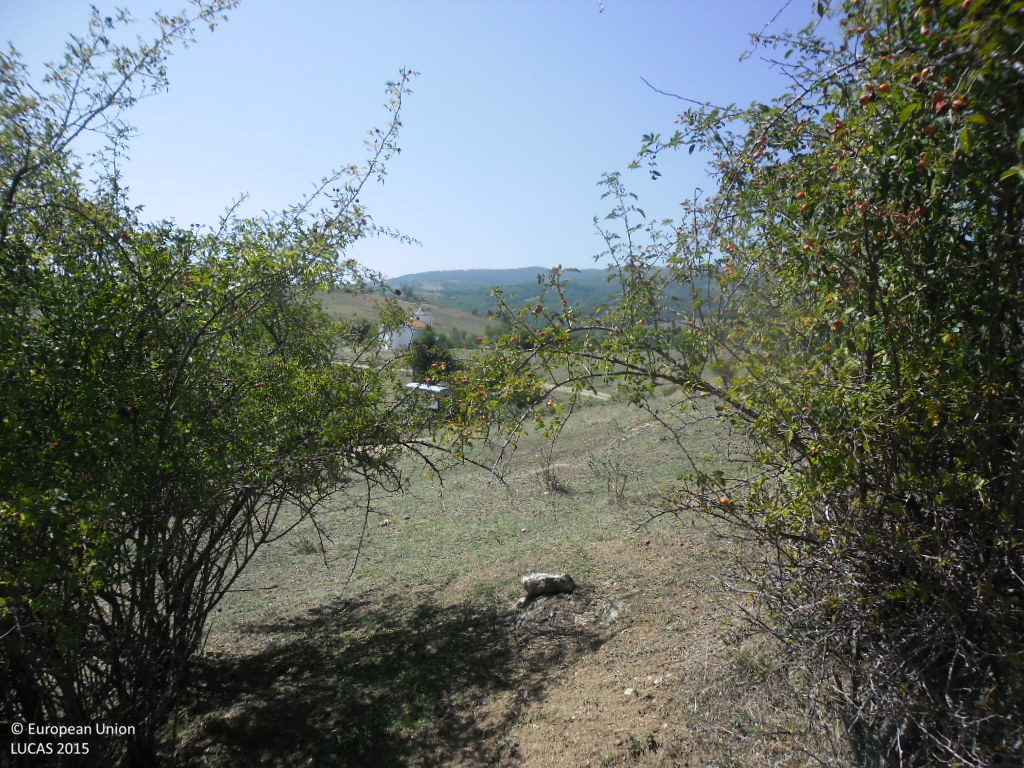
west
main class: Grassland
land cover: Grassland with sparse tree/shrub cover
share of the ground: > 75 %
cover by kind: herbaceous plants 90 %, broadleaved forest trees 5 %, shrubs 5 %
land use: Agriculture (excluding fallow land and kitchen gardens)
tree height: < 5 m
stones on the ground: < 10 %
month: September
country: BG
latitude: 41.4809
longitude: 23.1569
